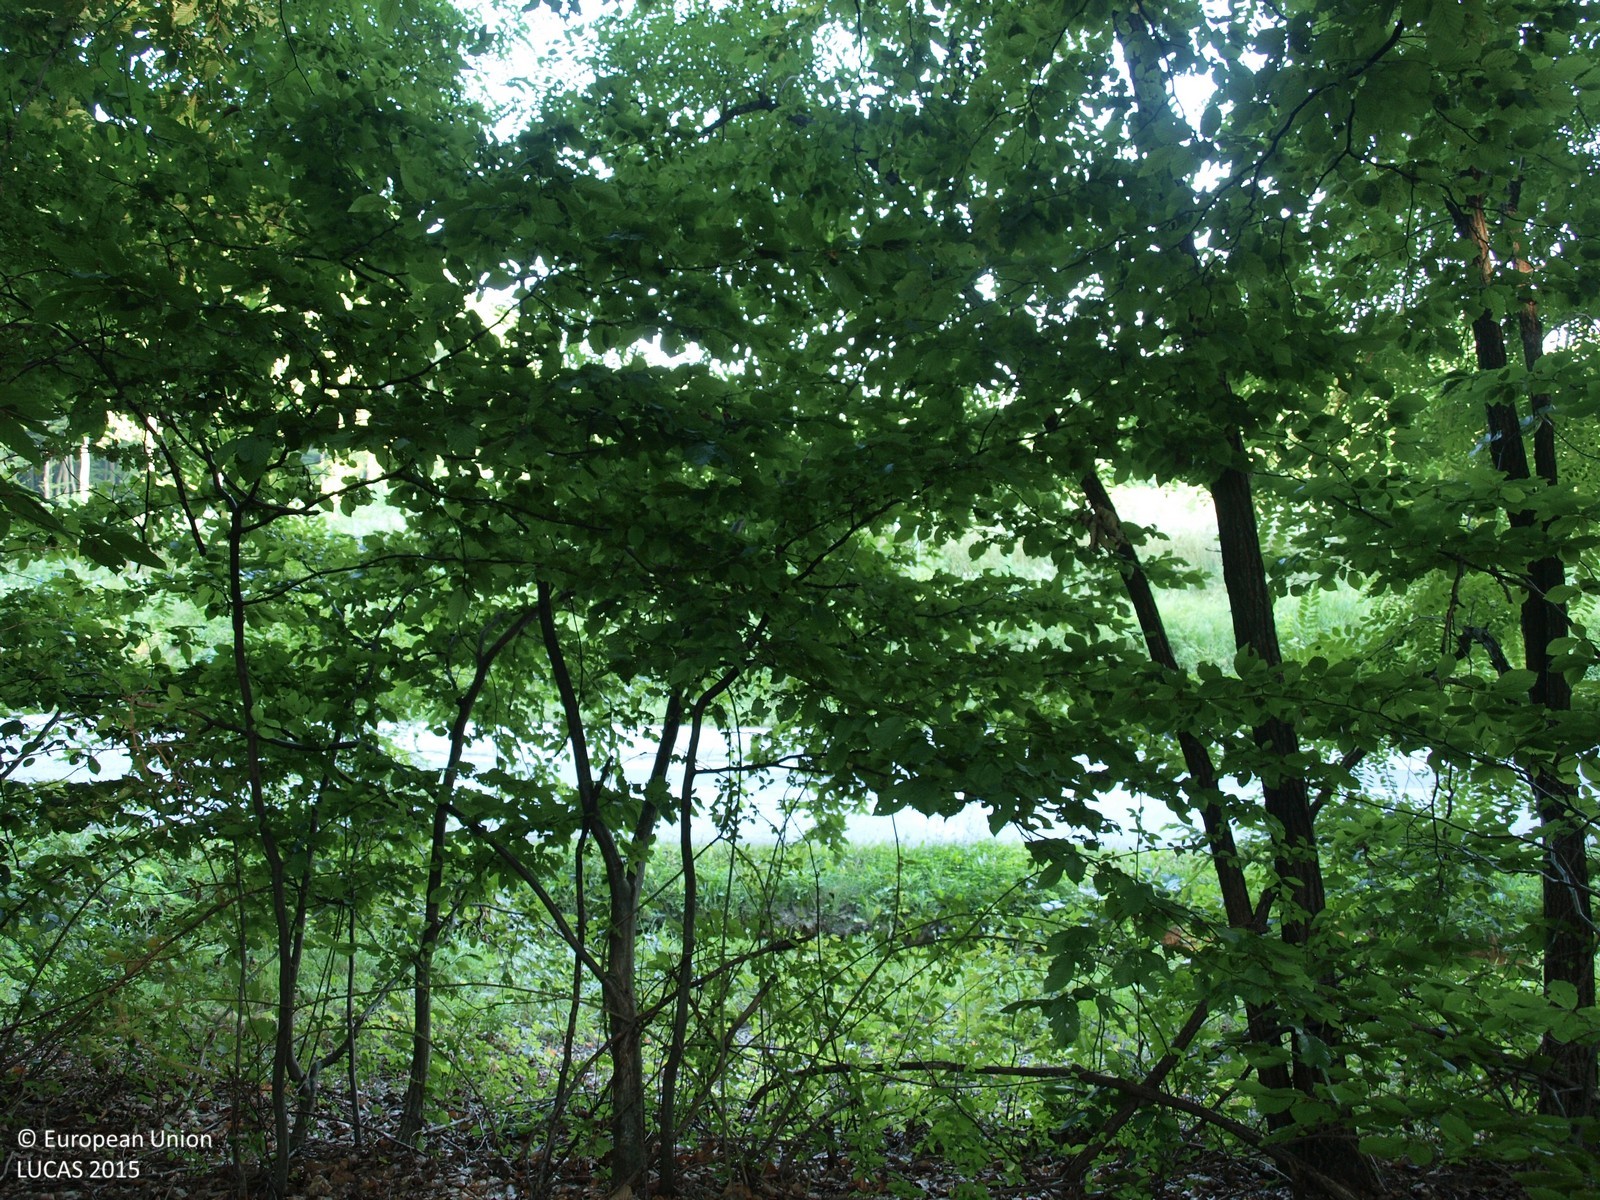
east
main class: Woodland
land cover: Broadleaved woodland
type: mesophytic deciduous forest
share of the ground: > 75 %
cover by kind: broadleaved forest trees 100 %
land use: Forestry
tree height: > 5 m
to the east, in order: Broadleaved woodland; Ditches and canals; Paved roads, cycling and walking lanes; Ditches and canals; Broadleaved woodland
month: August
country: HR
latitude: 45.8609
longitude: 16.5555
